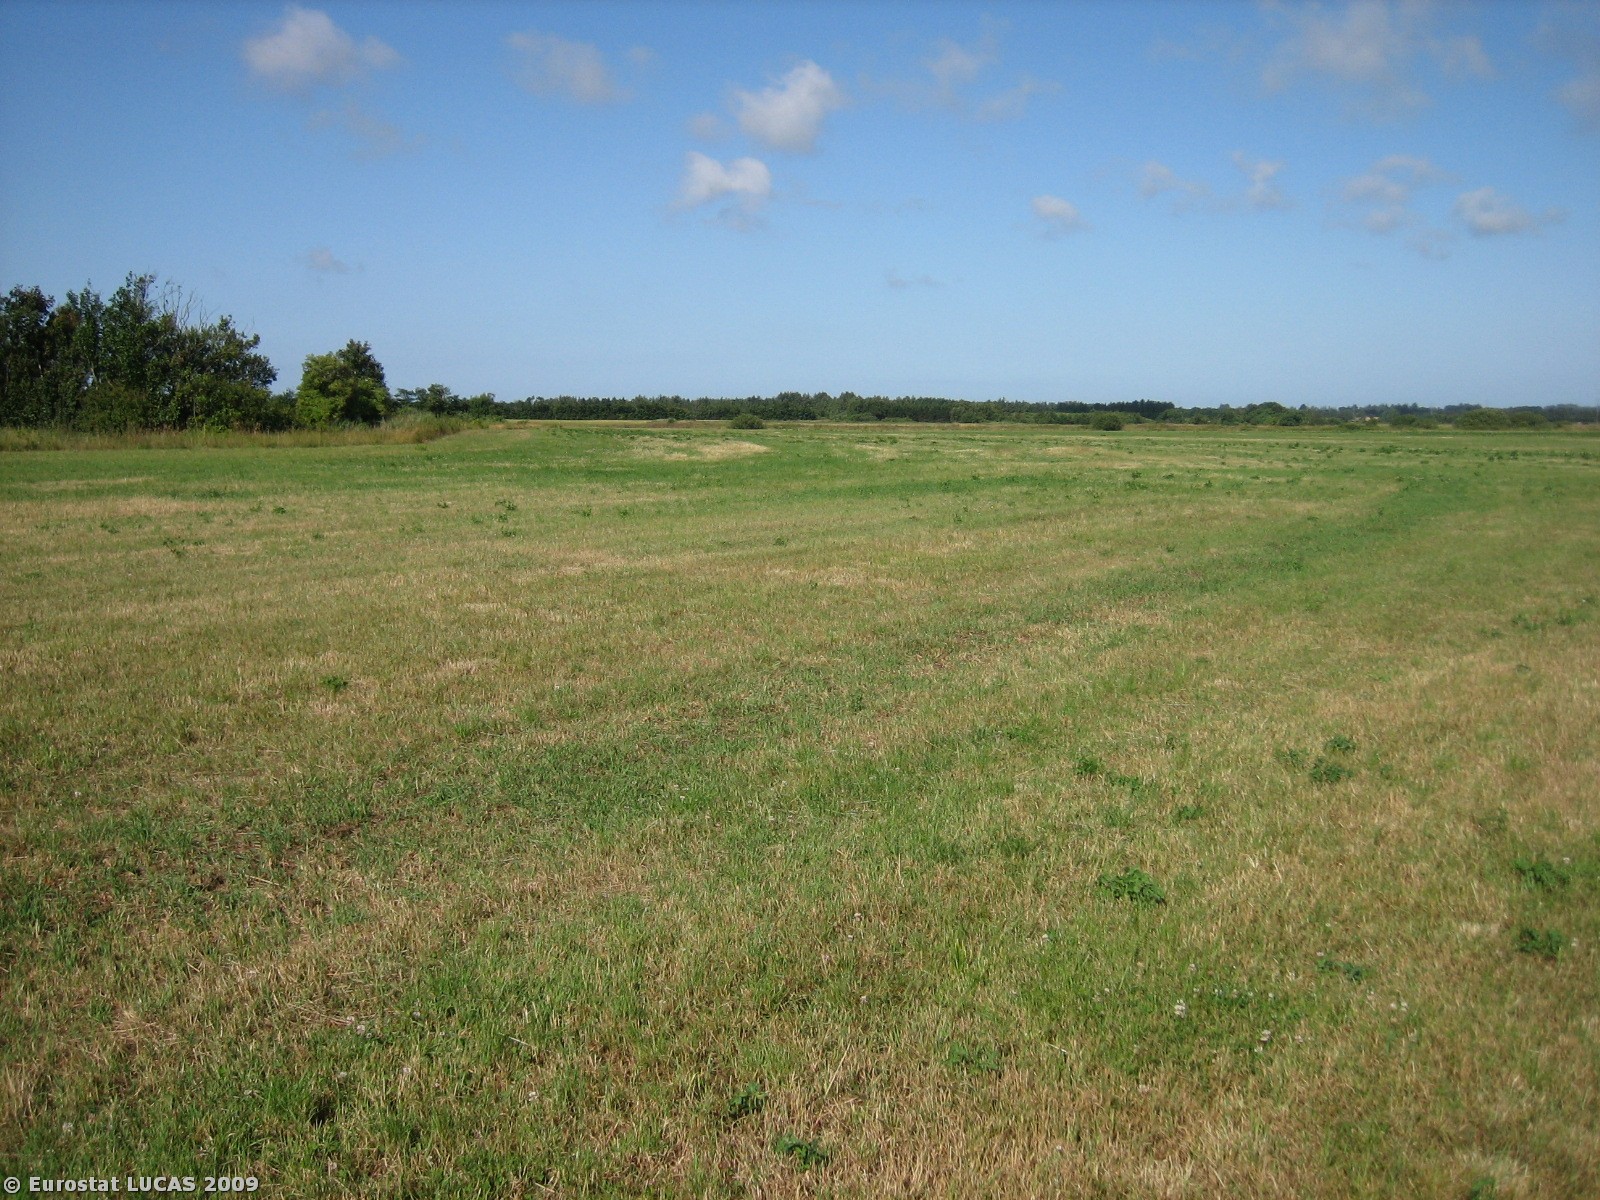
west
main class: Grassland
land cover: Grassland without tree/shrub cover
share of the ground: > 75 %
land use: Agriculture (excluding fallow land and kitchen gardens)
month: July
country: DK
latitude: 55.7270
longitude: 8.2979
